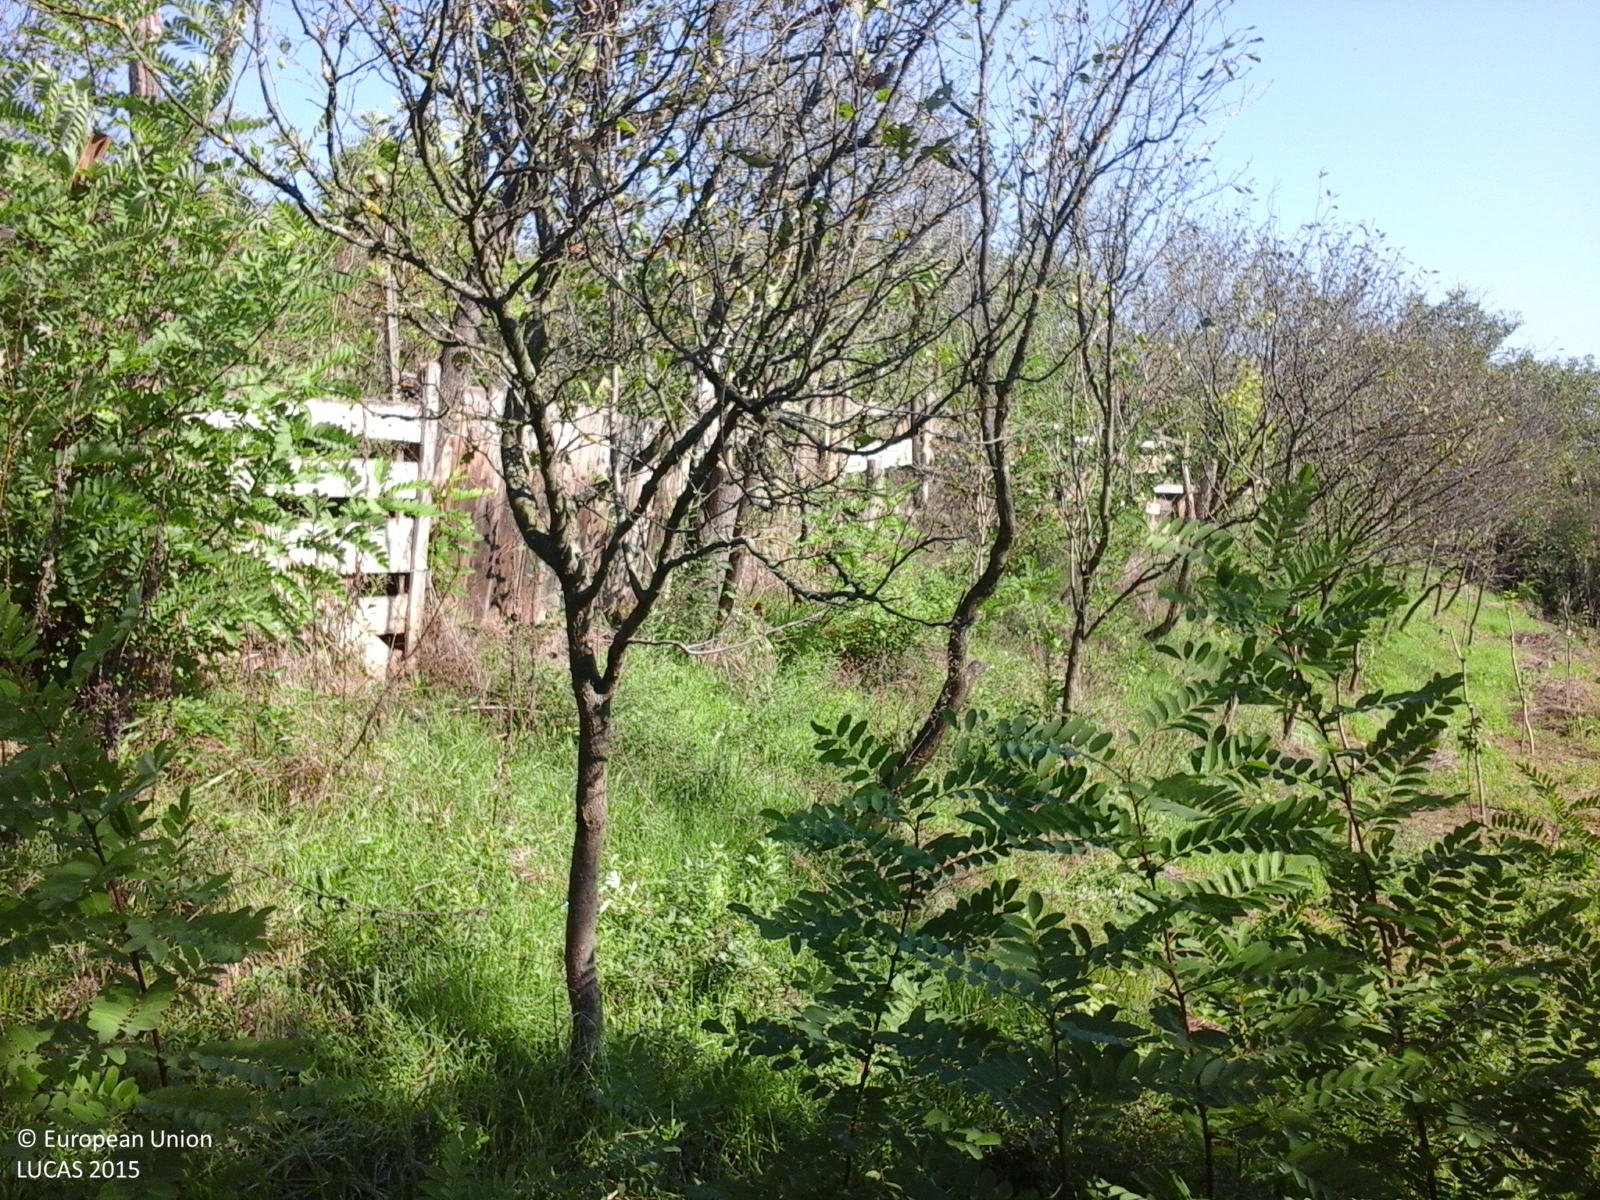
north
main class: Cropland
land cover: Other fruit trees and berries
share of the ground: 25 - 50 %
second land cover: Grassland without tree/shrub cover
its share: > 75 %
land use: Agriculture (excluding fallow land and kitchen gardens)
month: October
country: RO
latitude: 46.0740
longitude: 23.7885
